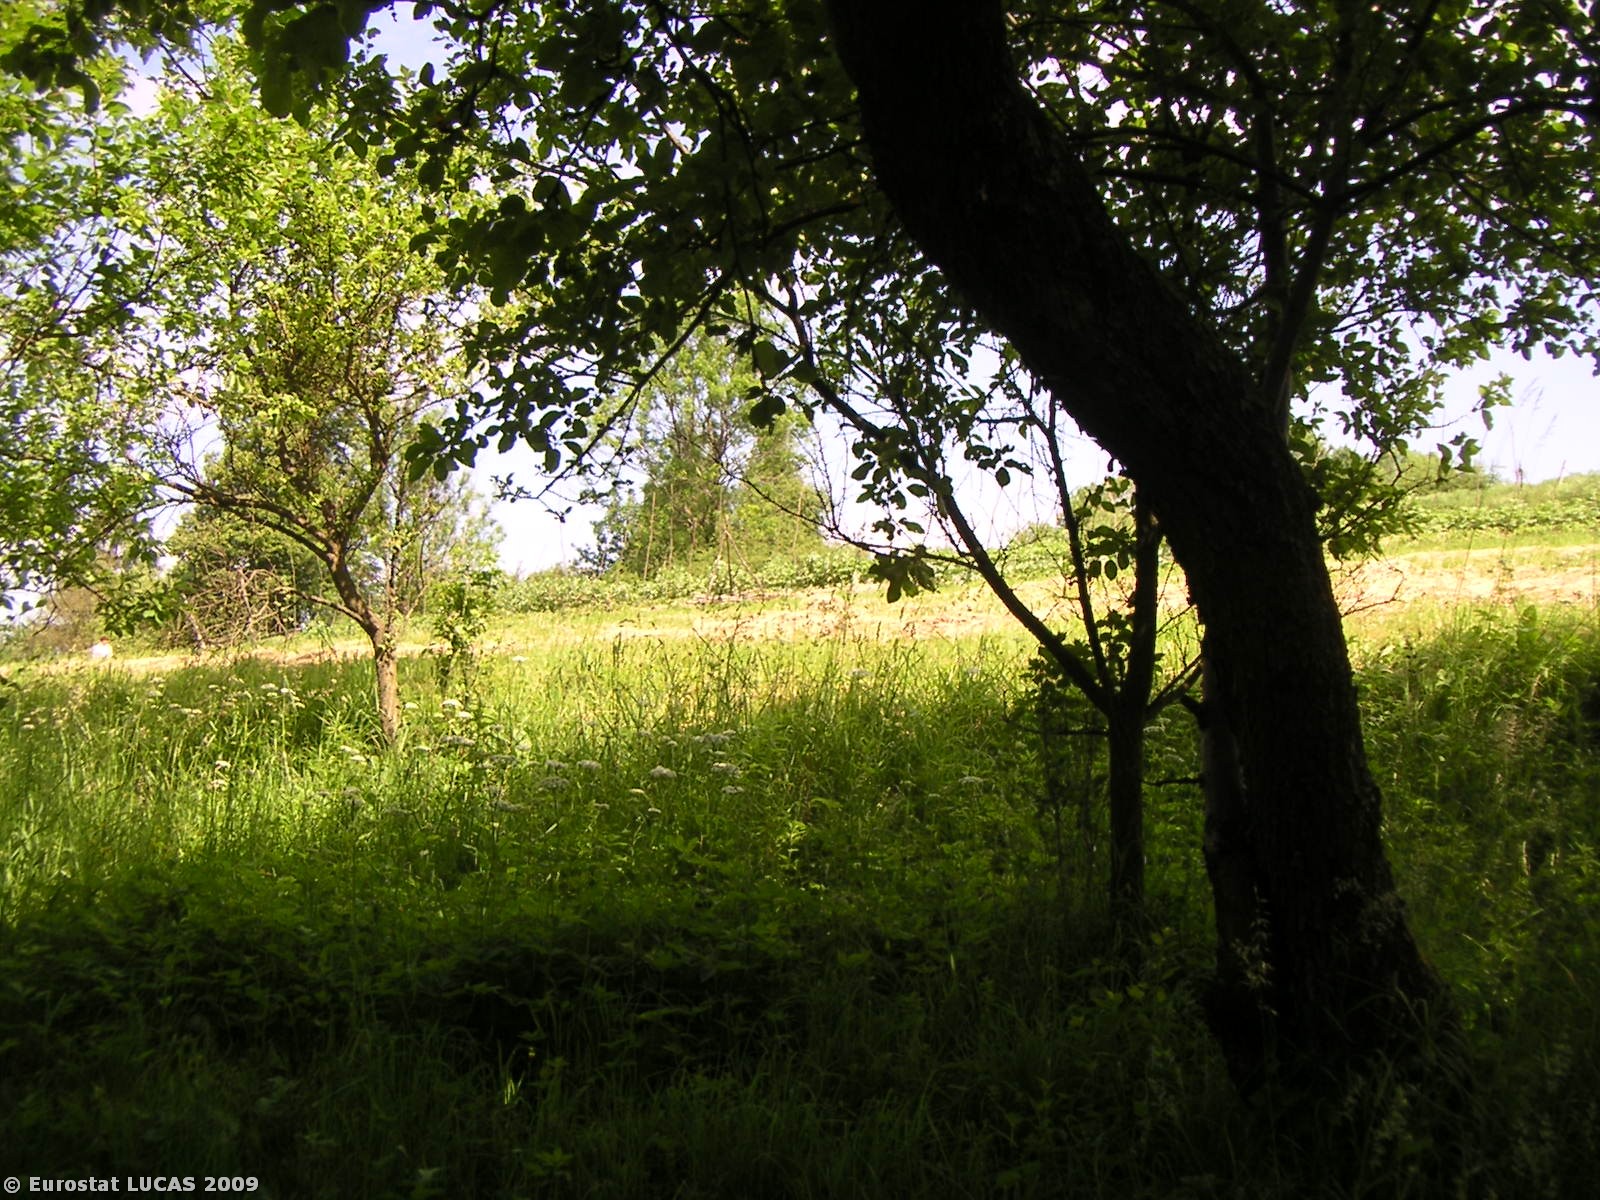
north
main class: Shrubland
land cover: Shrubland with sparse tree cover
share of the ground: > 75 %
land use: Unused
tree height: > 5 m
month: June
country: PL
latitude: 50.1881
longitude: 19.6792
